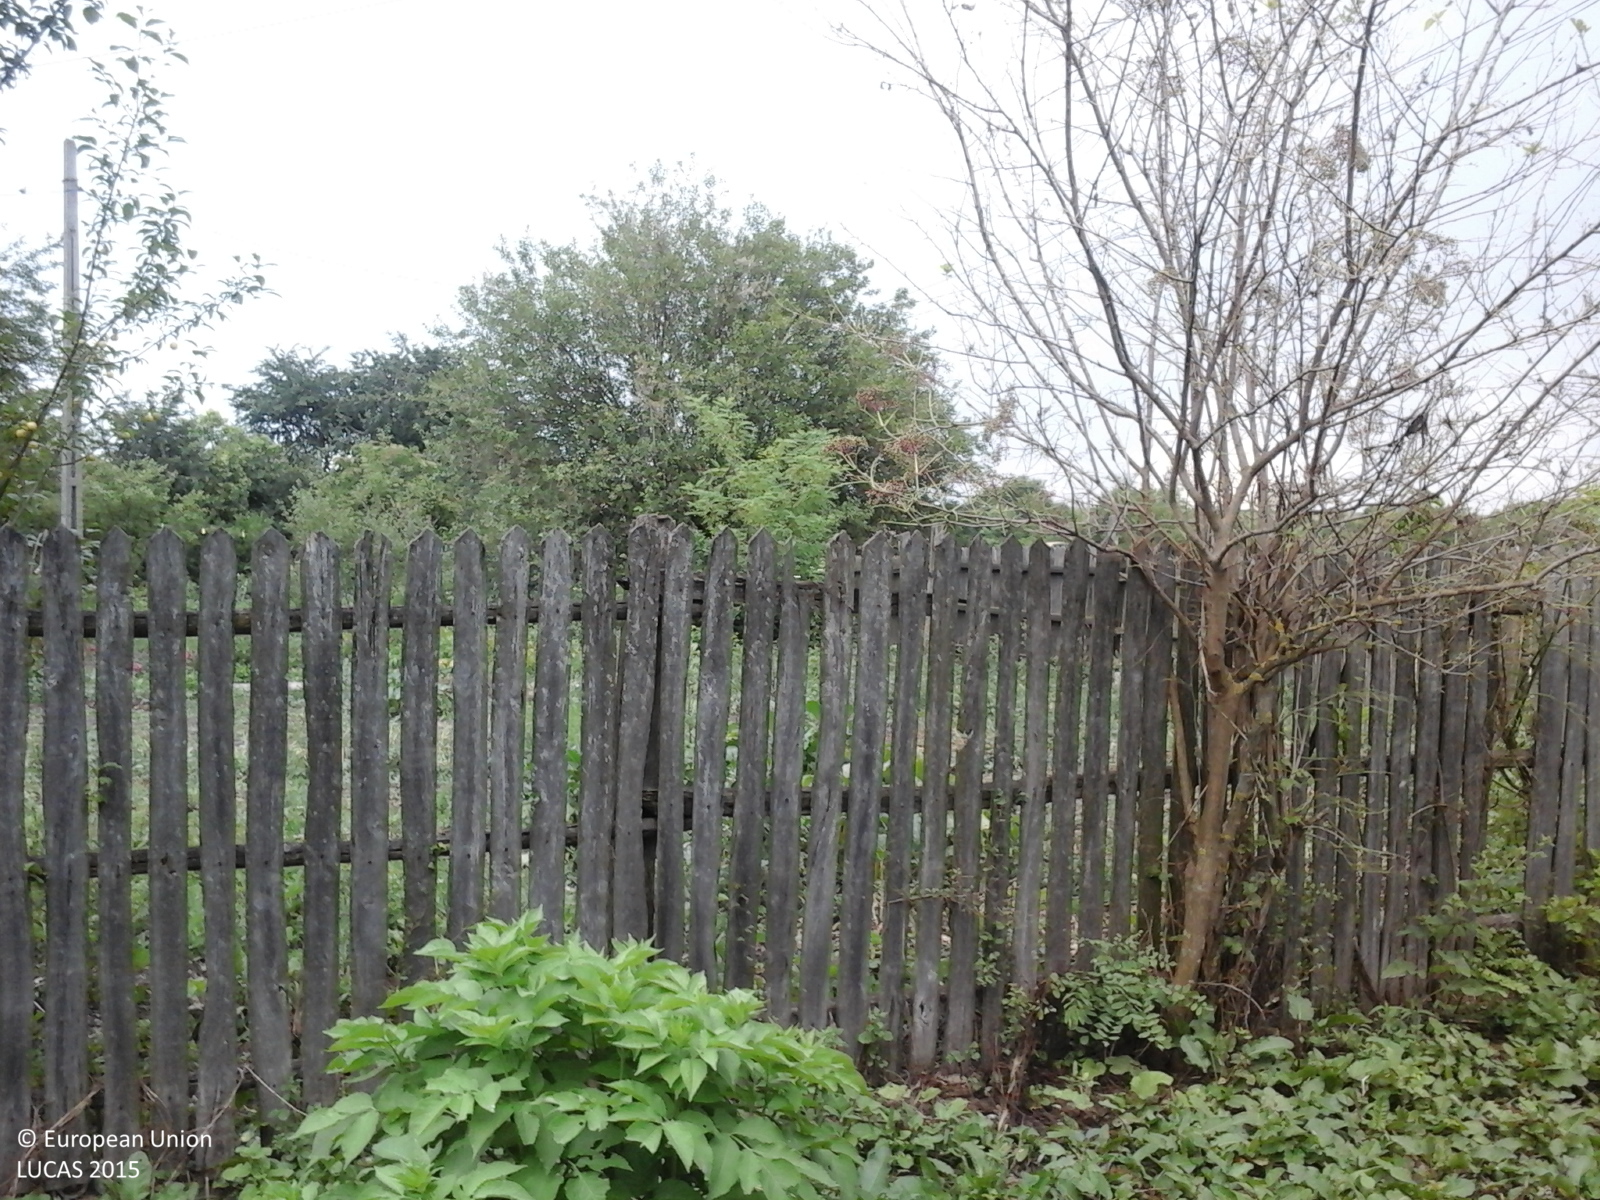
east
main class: Cropland
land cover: Other fresh vegetables
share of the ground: > 75 %
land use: Kitchen garden
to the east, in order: Other fresh vegetables; Artificial constructions in urban areas; Spontaneously vegetated surfaces; Artificial constructions in urban areas; Abandoned hedges; Artificial constructions in urban areas; Grassland without tree/shrub cover; Maize; Spontaneously vegetated surfaces; Tracks
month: July
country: RO
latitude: 44.1060
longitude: 24.8027
